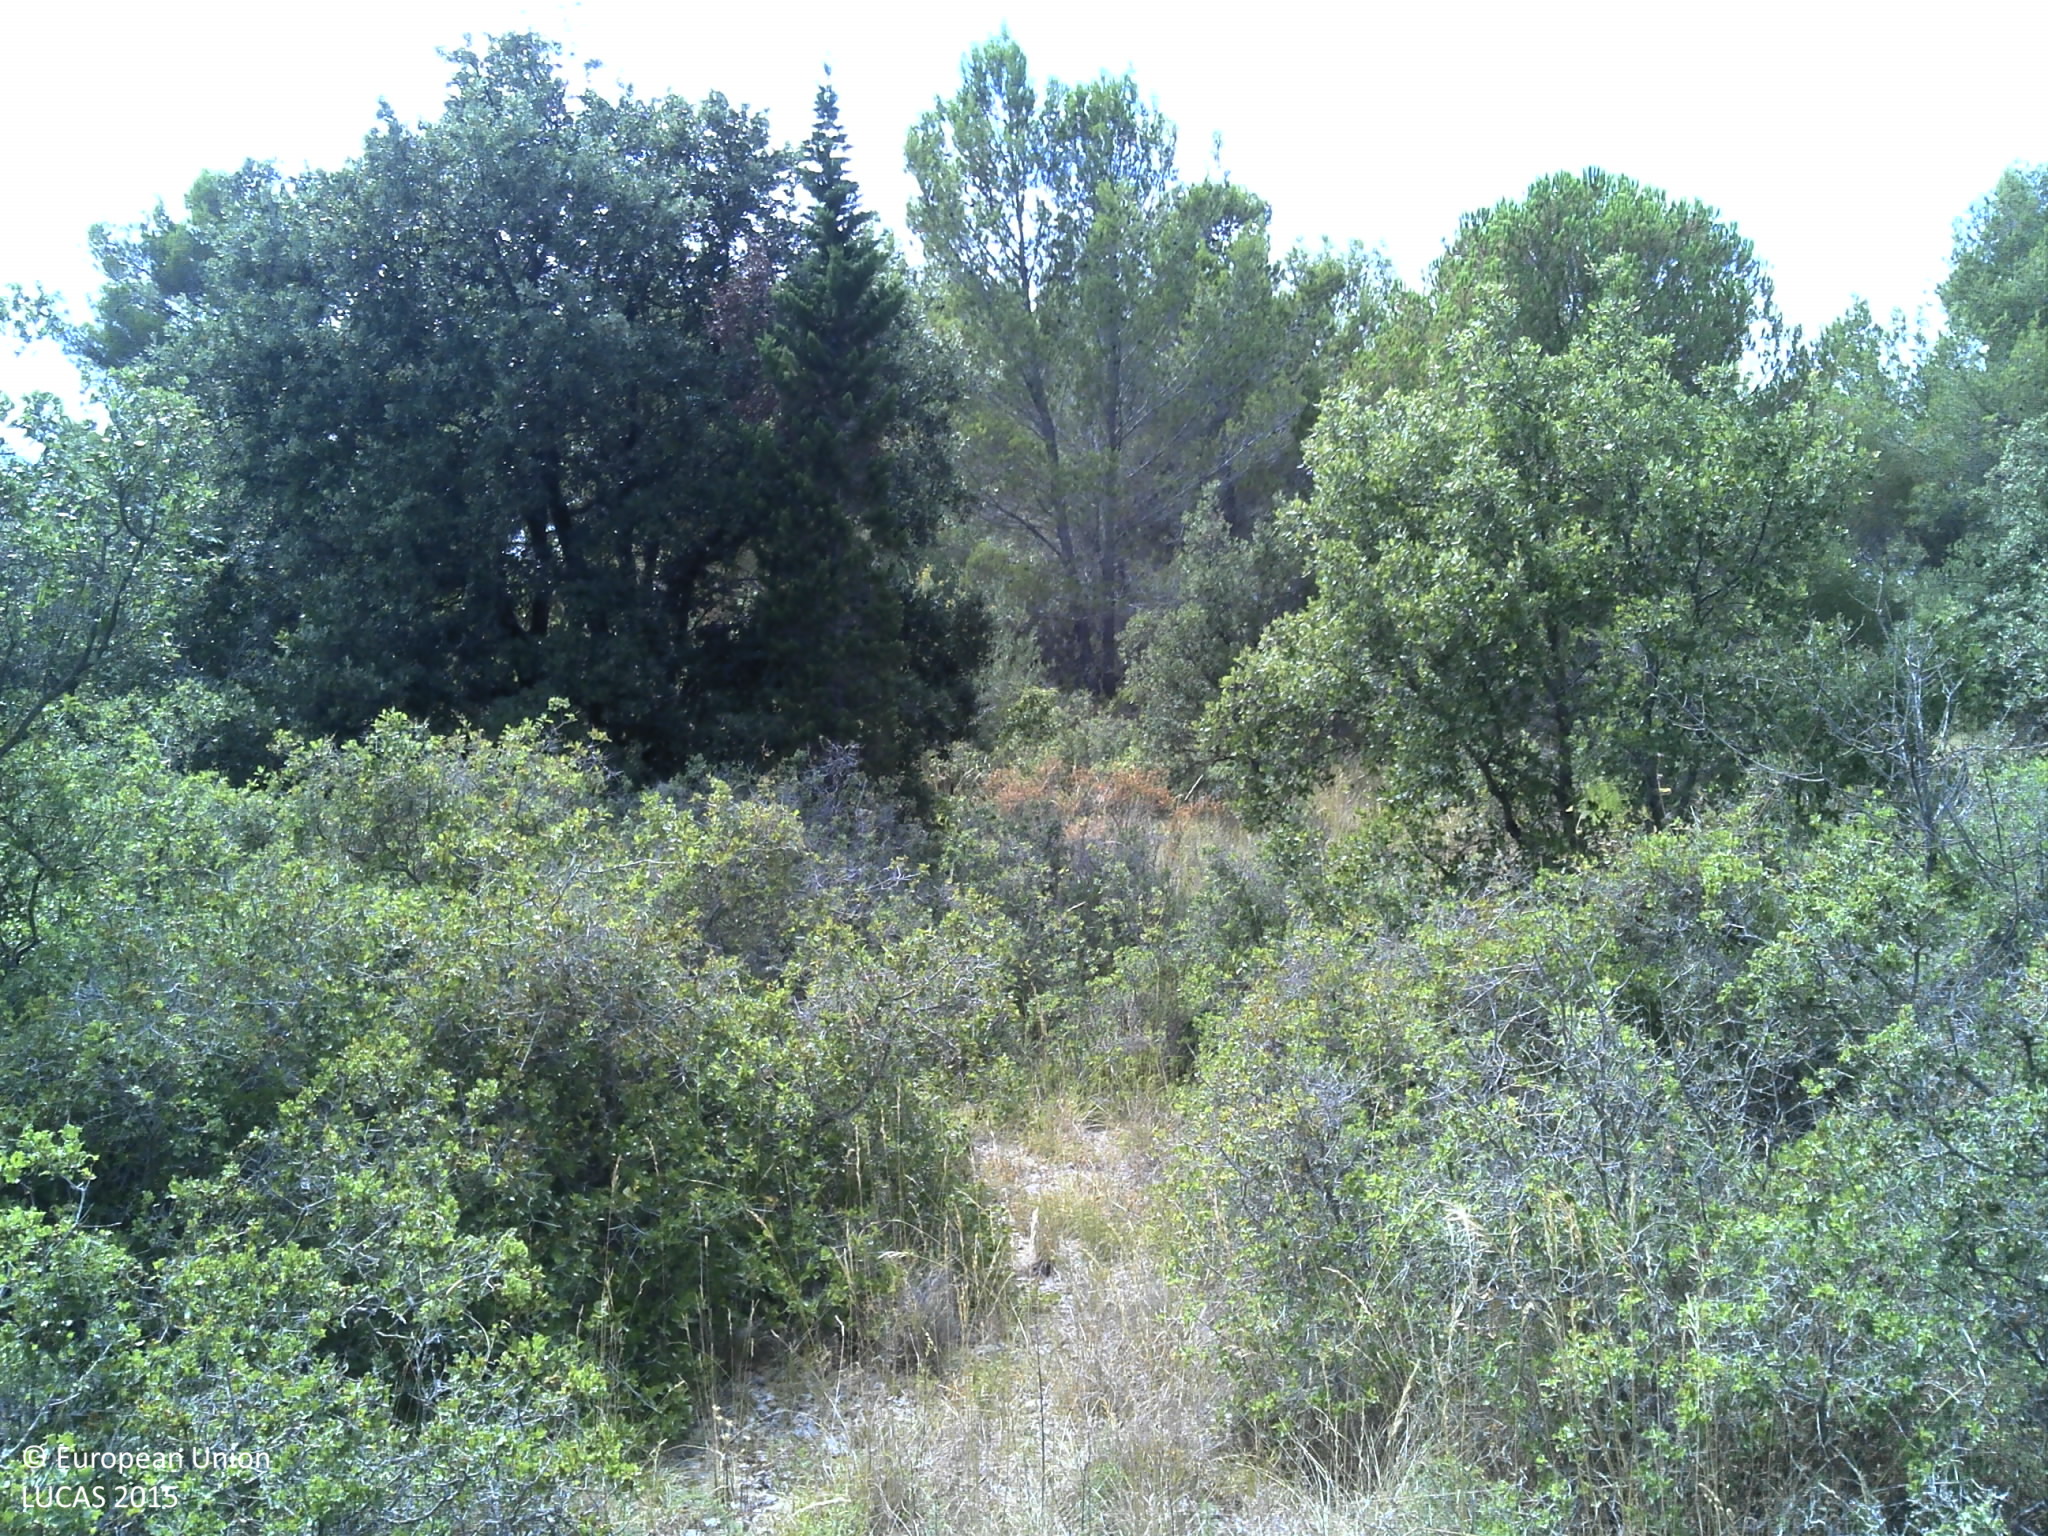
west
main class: Woodland
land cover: Broadleaved woodland
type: broadleaved evergreen forest
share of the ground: > 75 %
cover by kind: broadleaved forest trees 55 %, coniferous forest trees 15 %, shrubs 15 %, herbaceous plants 5 %, consolidated bare surface 5 %, unconsolidated bare surface 5 %
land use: Semi-natural and natural areas not in use
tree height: > 5 m
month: July
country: FR
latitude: 43.4666
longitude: 3.6190
